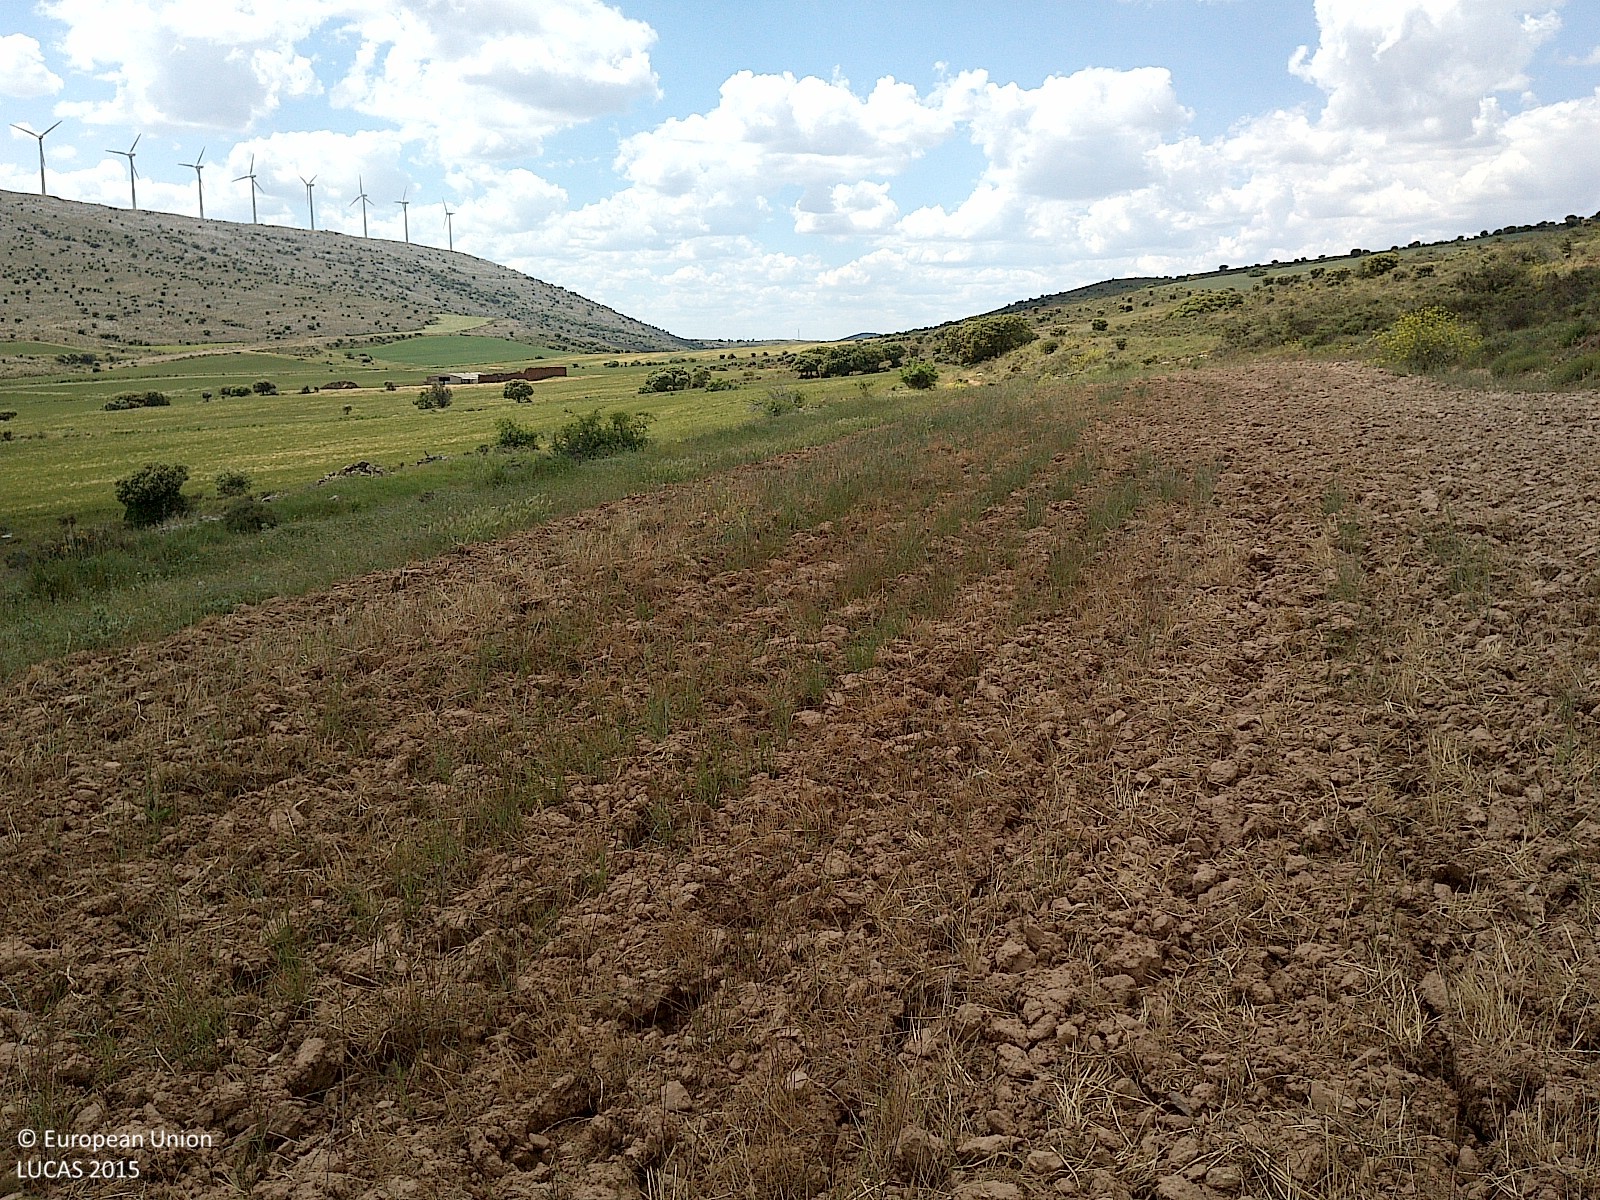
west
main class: Grassland
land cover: Spontaneously vegetated surfaces
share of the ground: 10 - 25 %
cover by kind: unconsolidated bare surface 80 %, herbaceous plants 20 %
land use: Fallow land
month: June
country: ES
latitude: 41.7531
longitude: -2.1692
